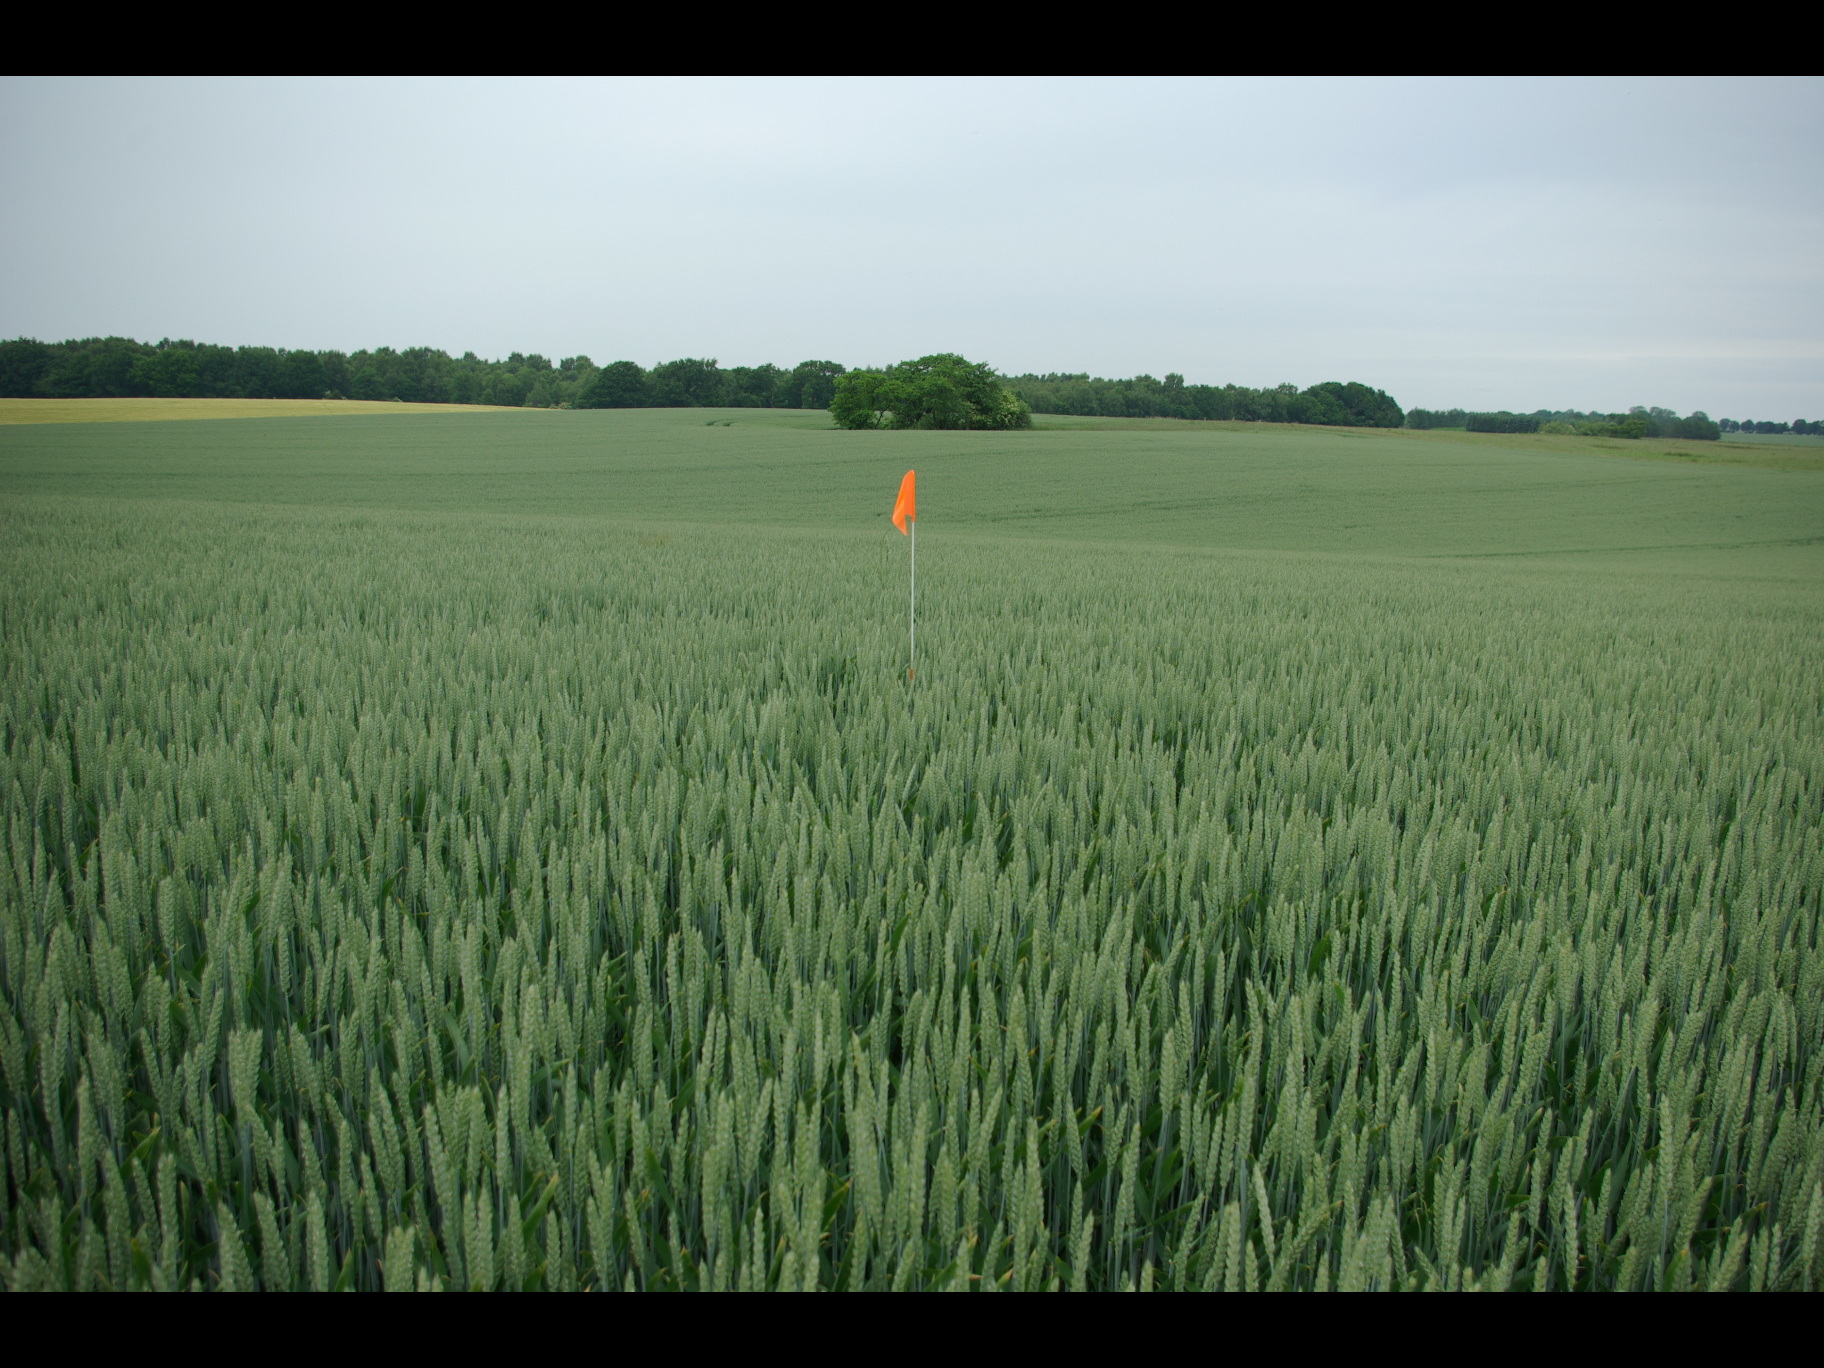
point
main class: Cropland
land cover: Common wheat
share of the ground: > 75 %
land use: Agriculture (excluding fallow land and kitchen gardens)
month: June
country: DE
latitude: 54.5162
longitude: 9.9228
